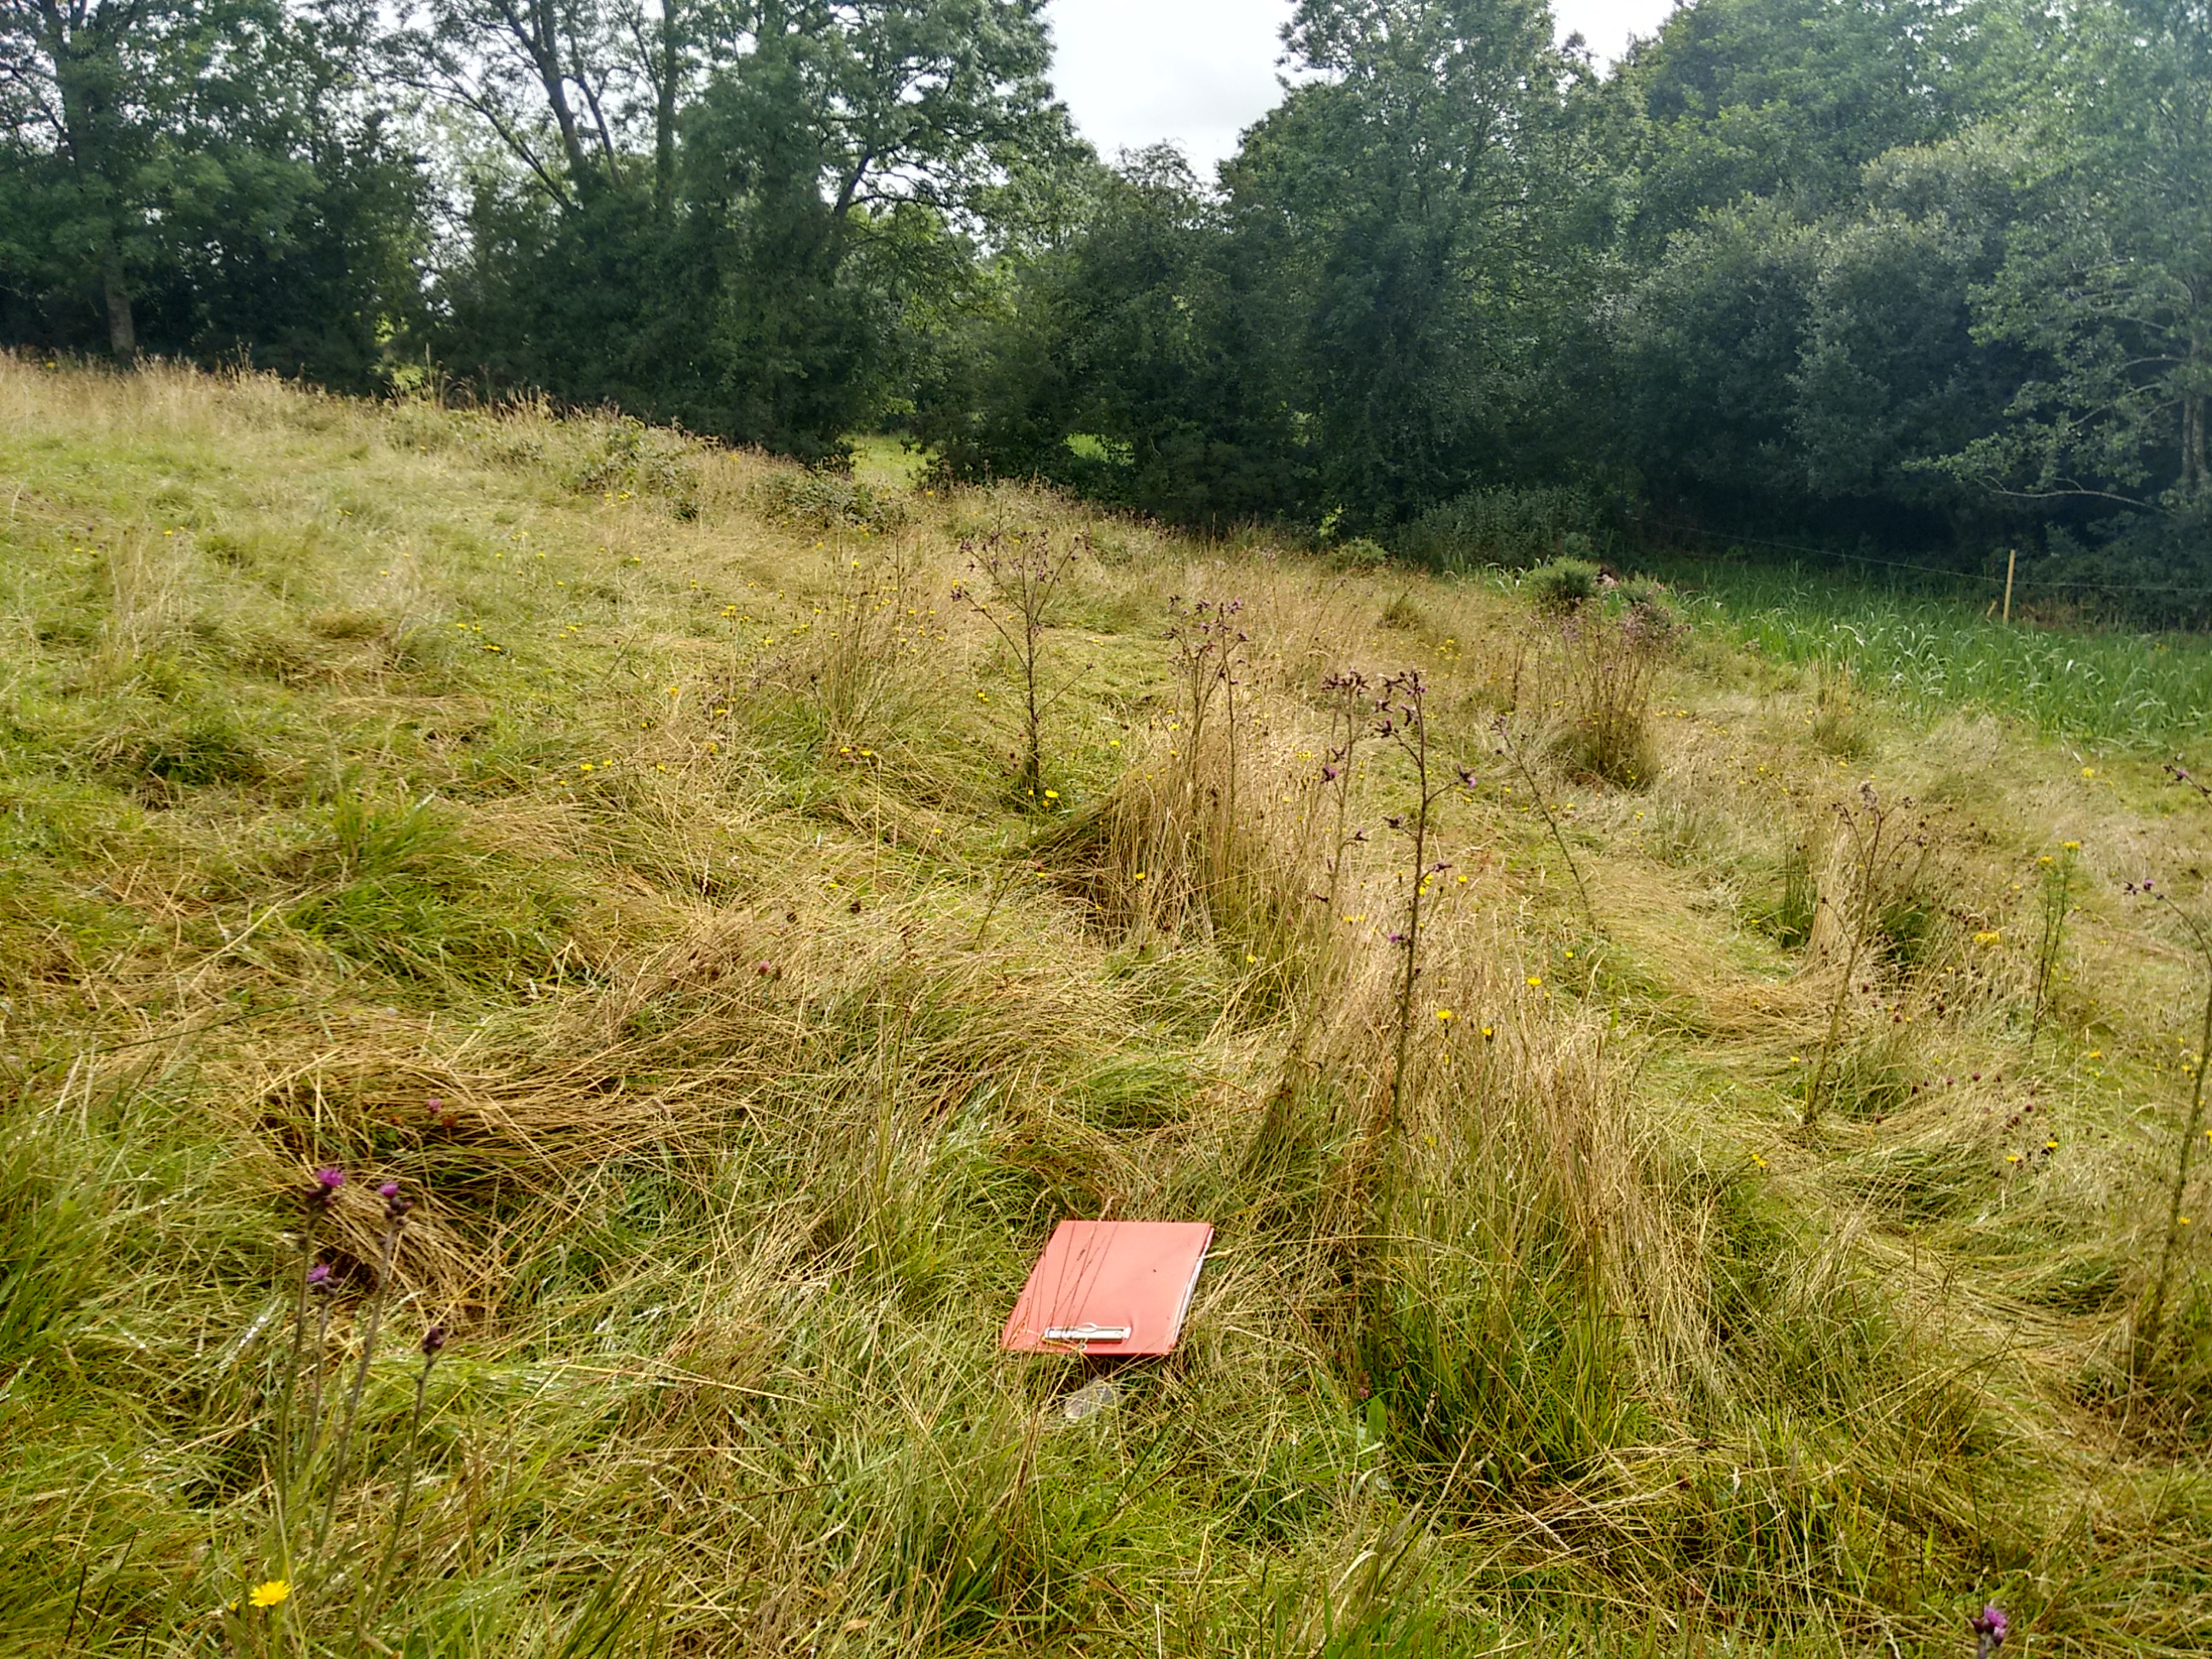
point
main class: Grassland
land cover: Grassland without tree/shrub cover
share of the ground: > 75 %
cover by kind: herbaceous plants 100 %
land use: Agriculture (excluding fallow land and kitchen gardens)
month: August
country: GB
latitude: 54.3719
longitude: -6.7730
